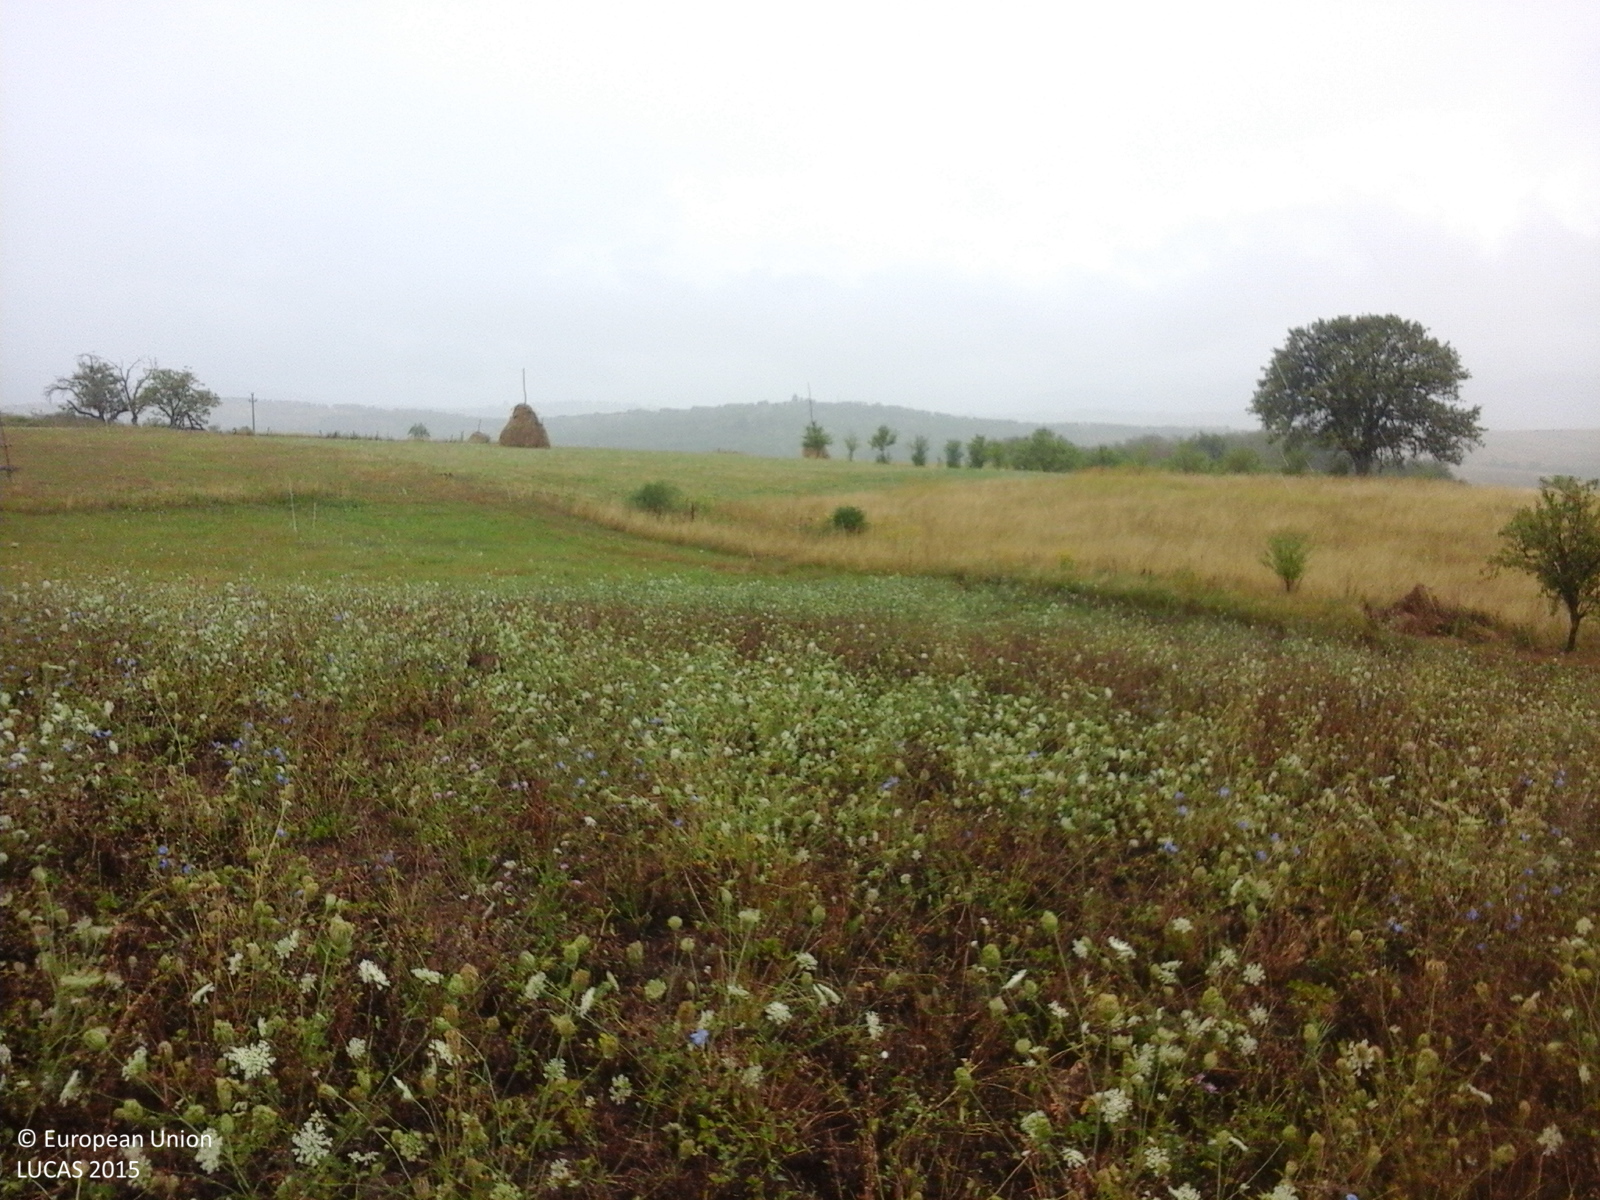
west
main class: Grassland
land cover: Spontaneously vegetated surfaces
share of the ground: > 75 %
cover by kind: herbaceous plants 100 %
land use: Fallow land
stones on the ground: 25 - 50 %
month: August
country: RO
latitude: 44.8814
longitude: 22.0749
